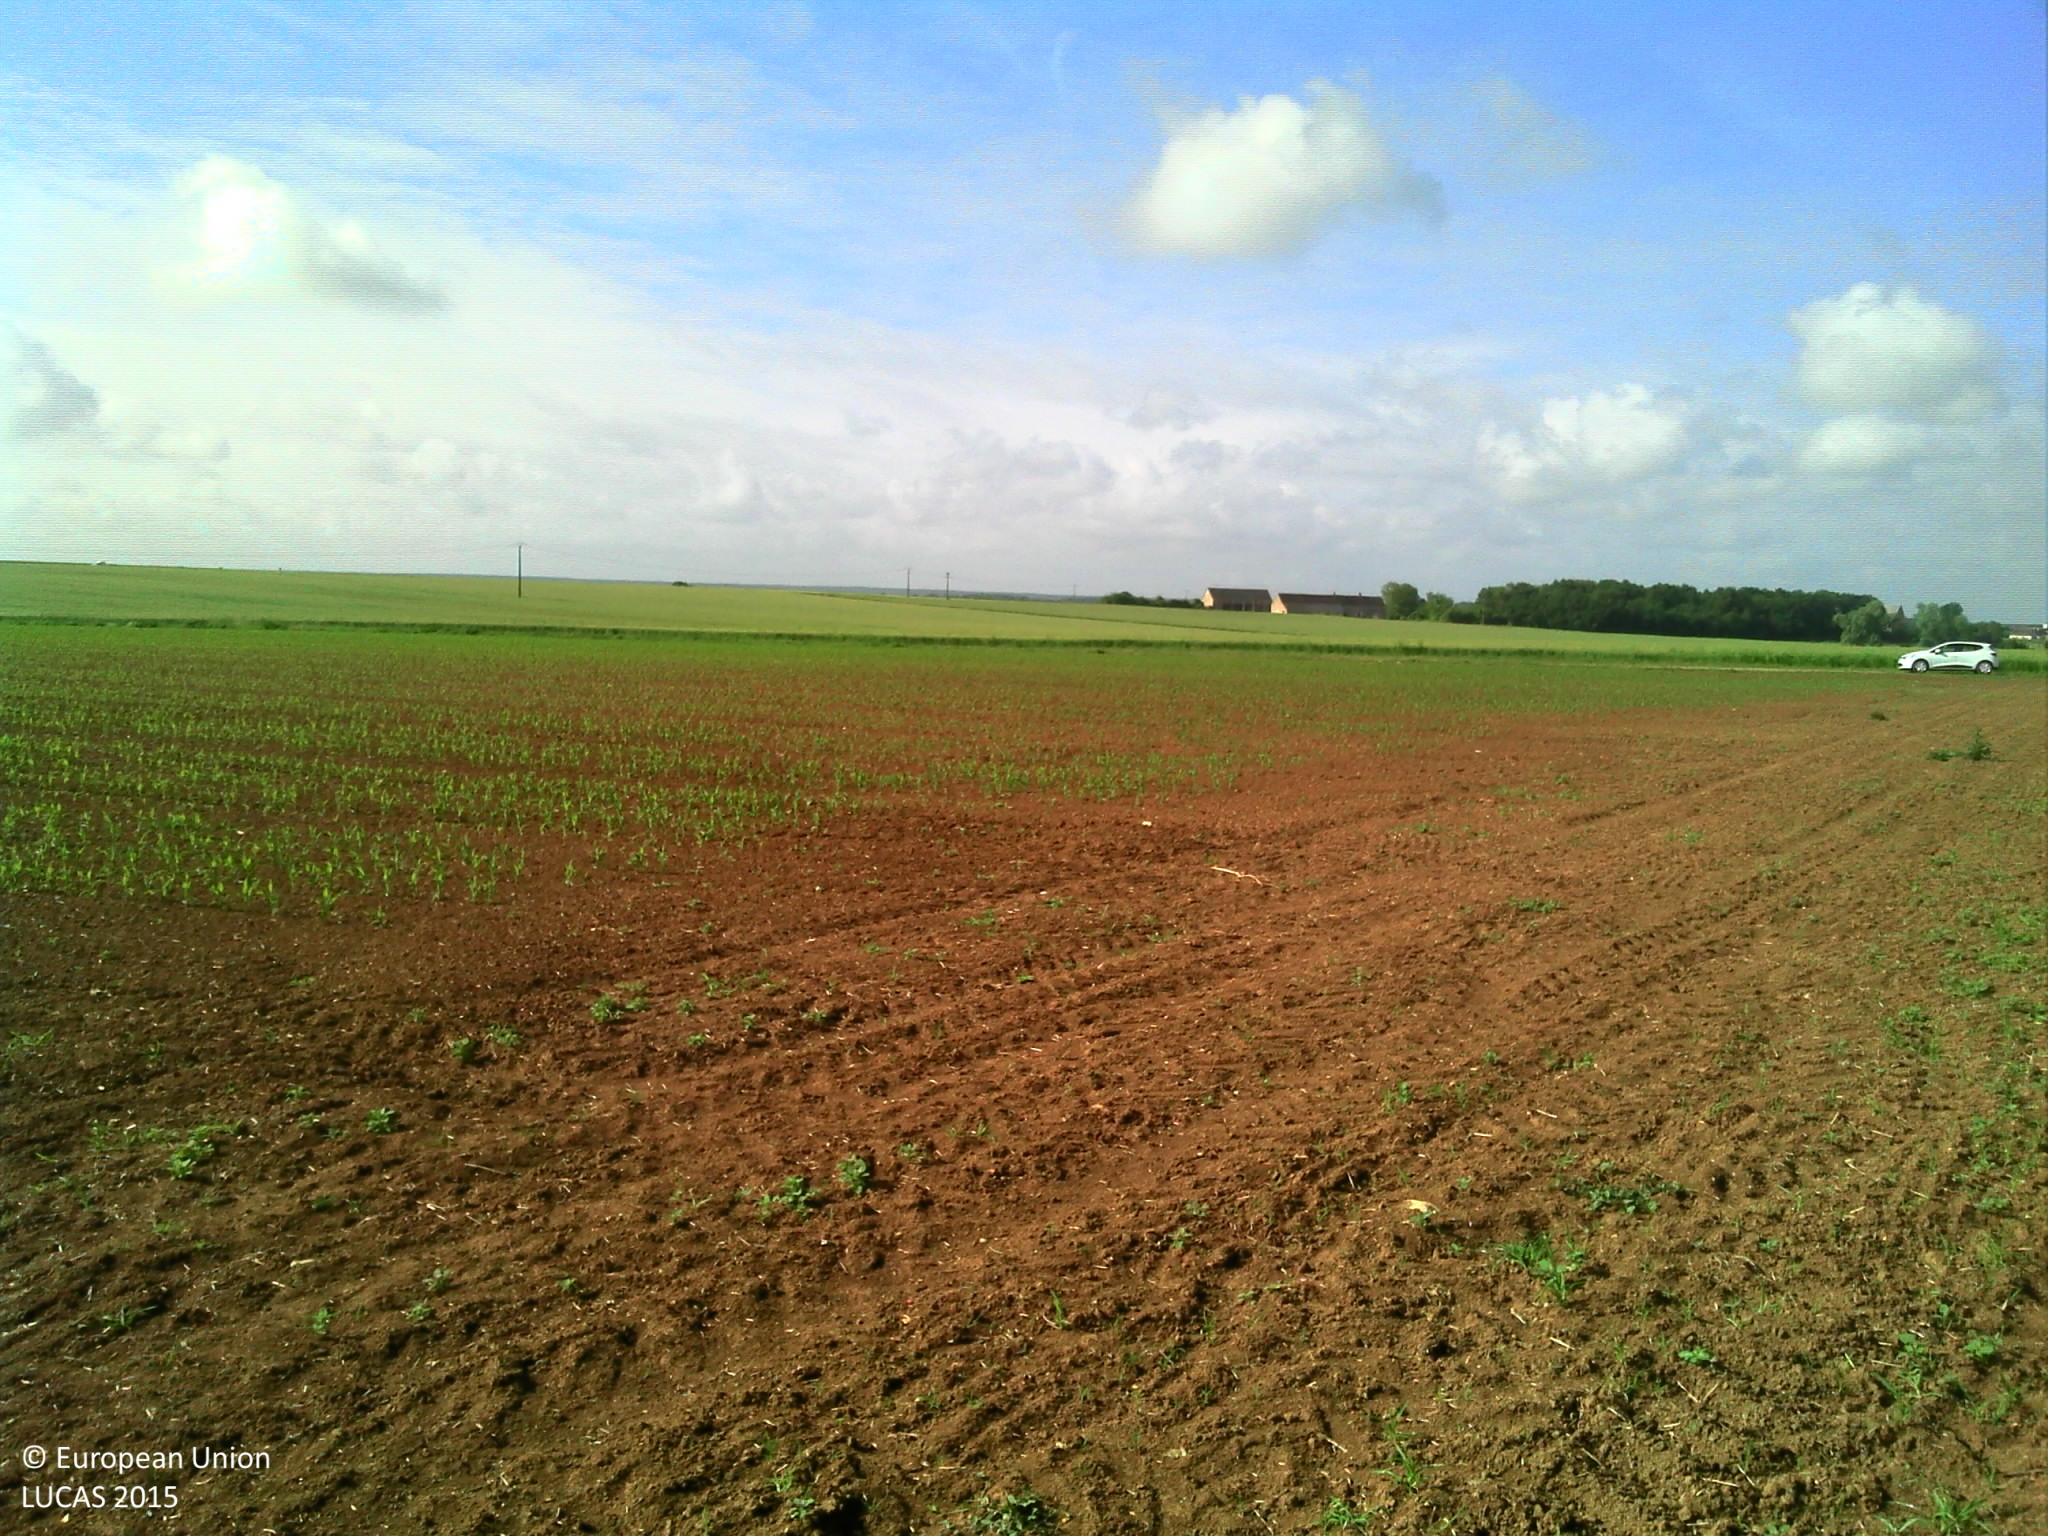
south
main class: Cropland
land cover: Rape and turnip rape
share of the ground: > 75 %
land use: Agriculture (excluding fallow land and kitchen gardens)
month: June
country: FR
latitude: 47.2425
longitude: 1.0400
